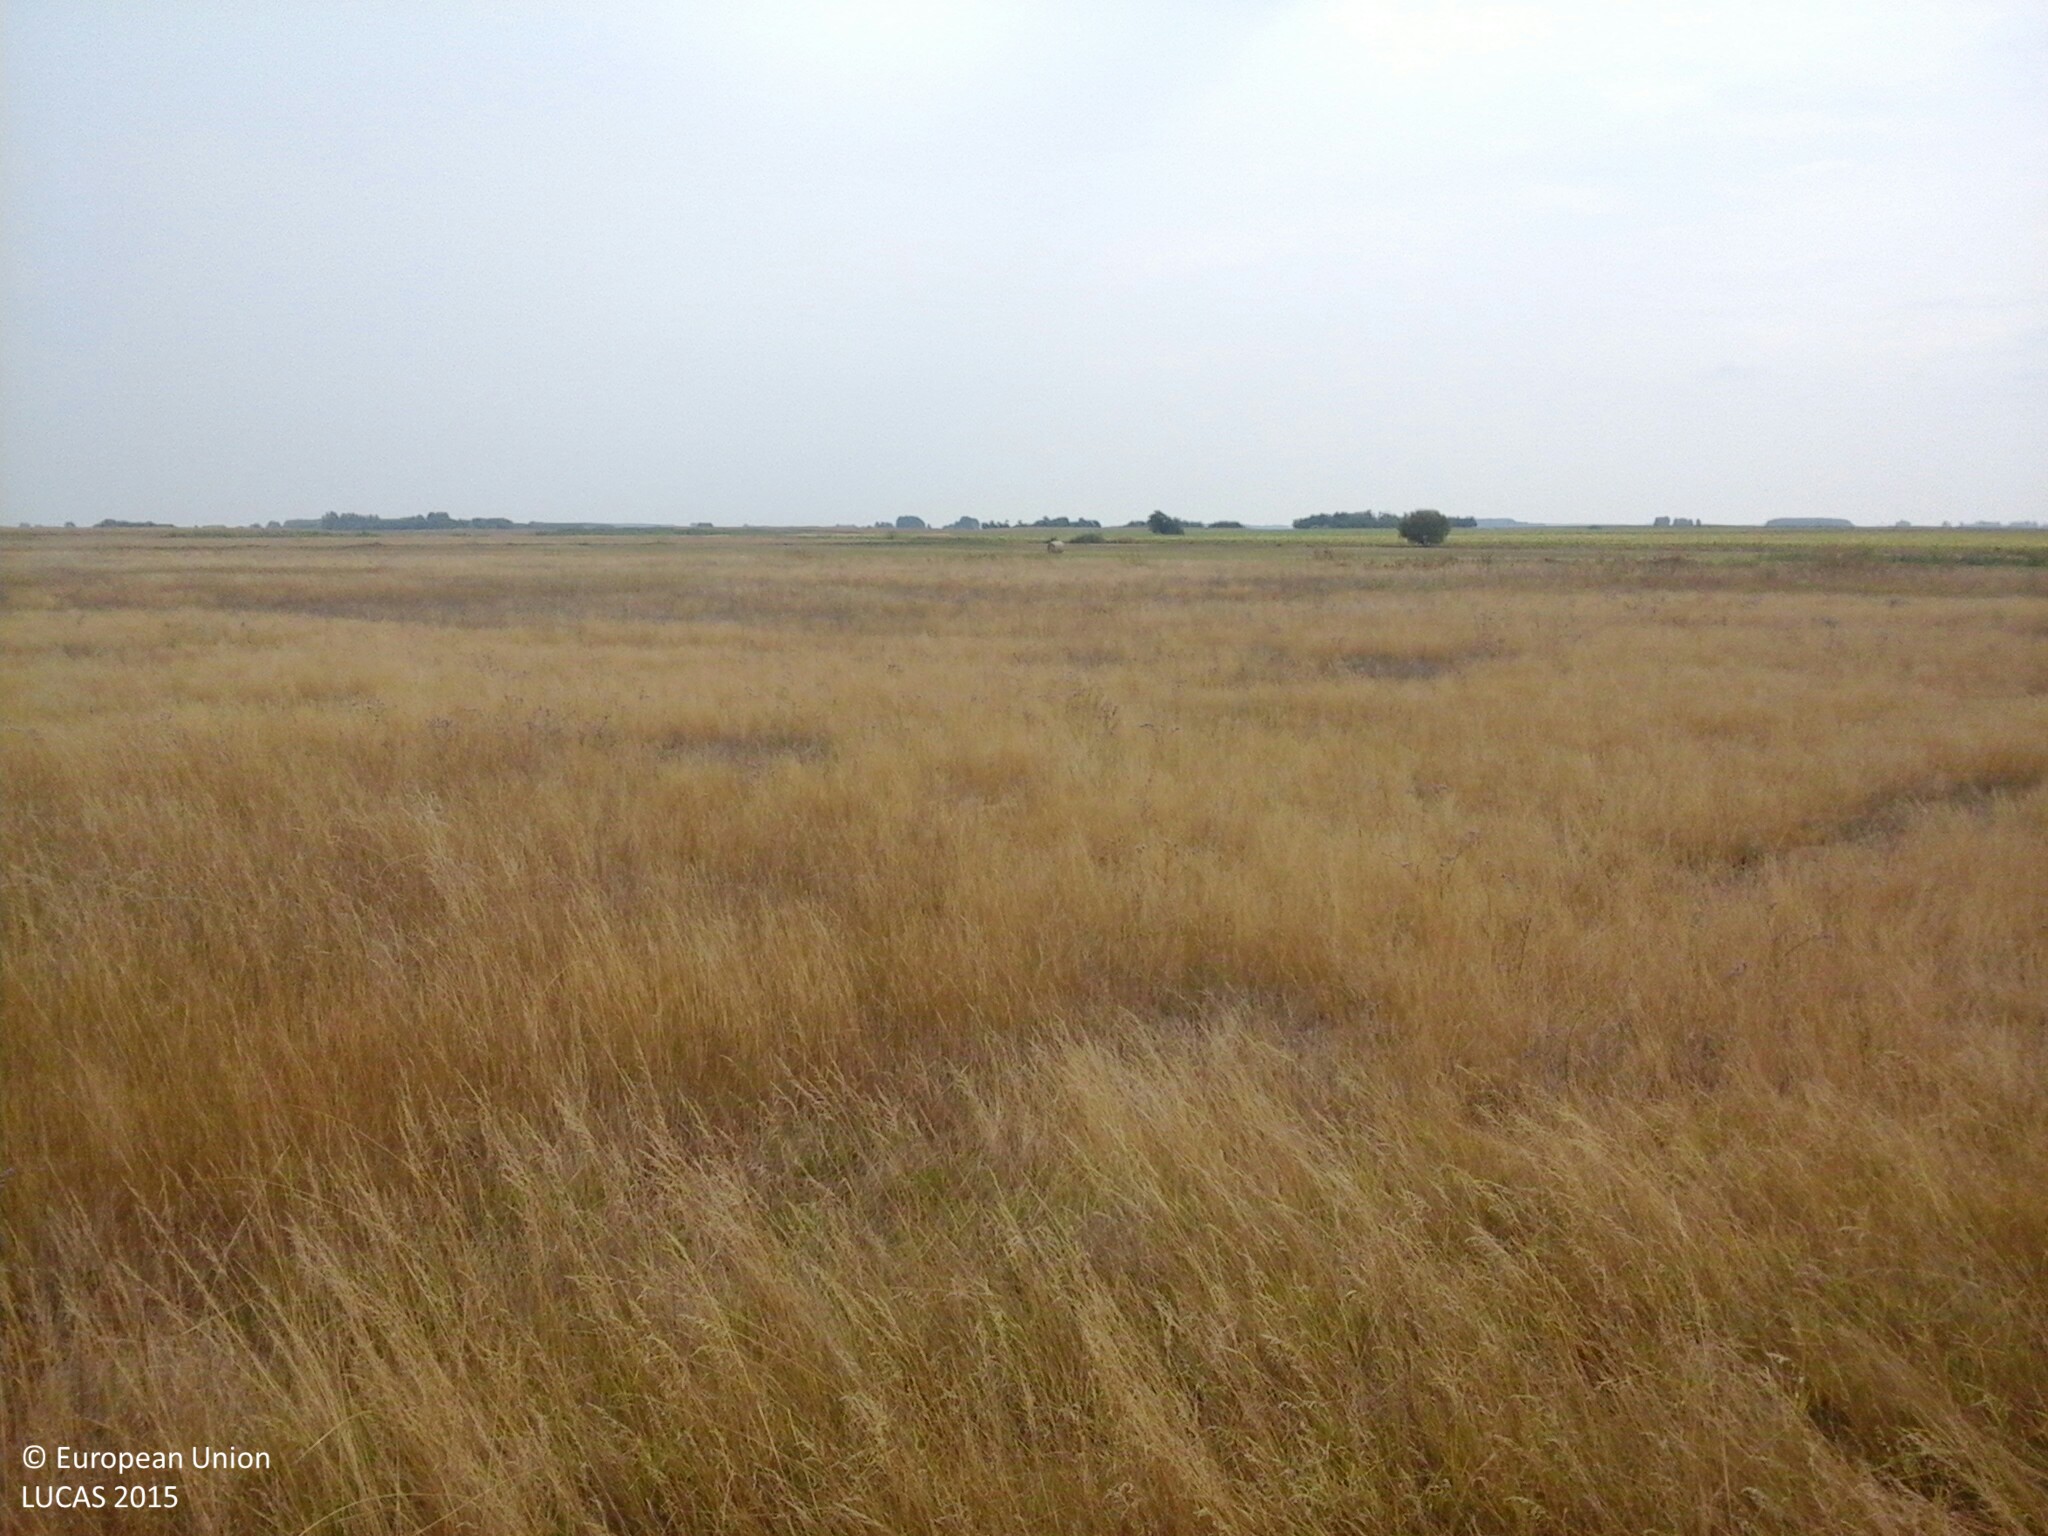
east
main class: Grassland
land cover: Grassland without tree/shrub cover
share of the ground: > 75 %
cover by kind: herbaceous plants 100 %
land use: Semi-natural and natural areas not in use
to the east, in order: Grassland without tree/shrub cover
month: August
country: HU
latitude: 47.0553
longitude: 21.5072
